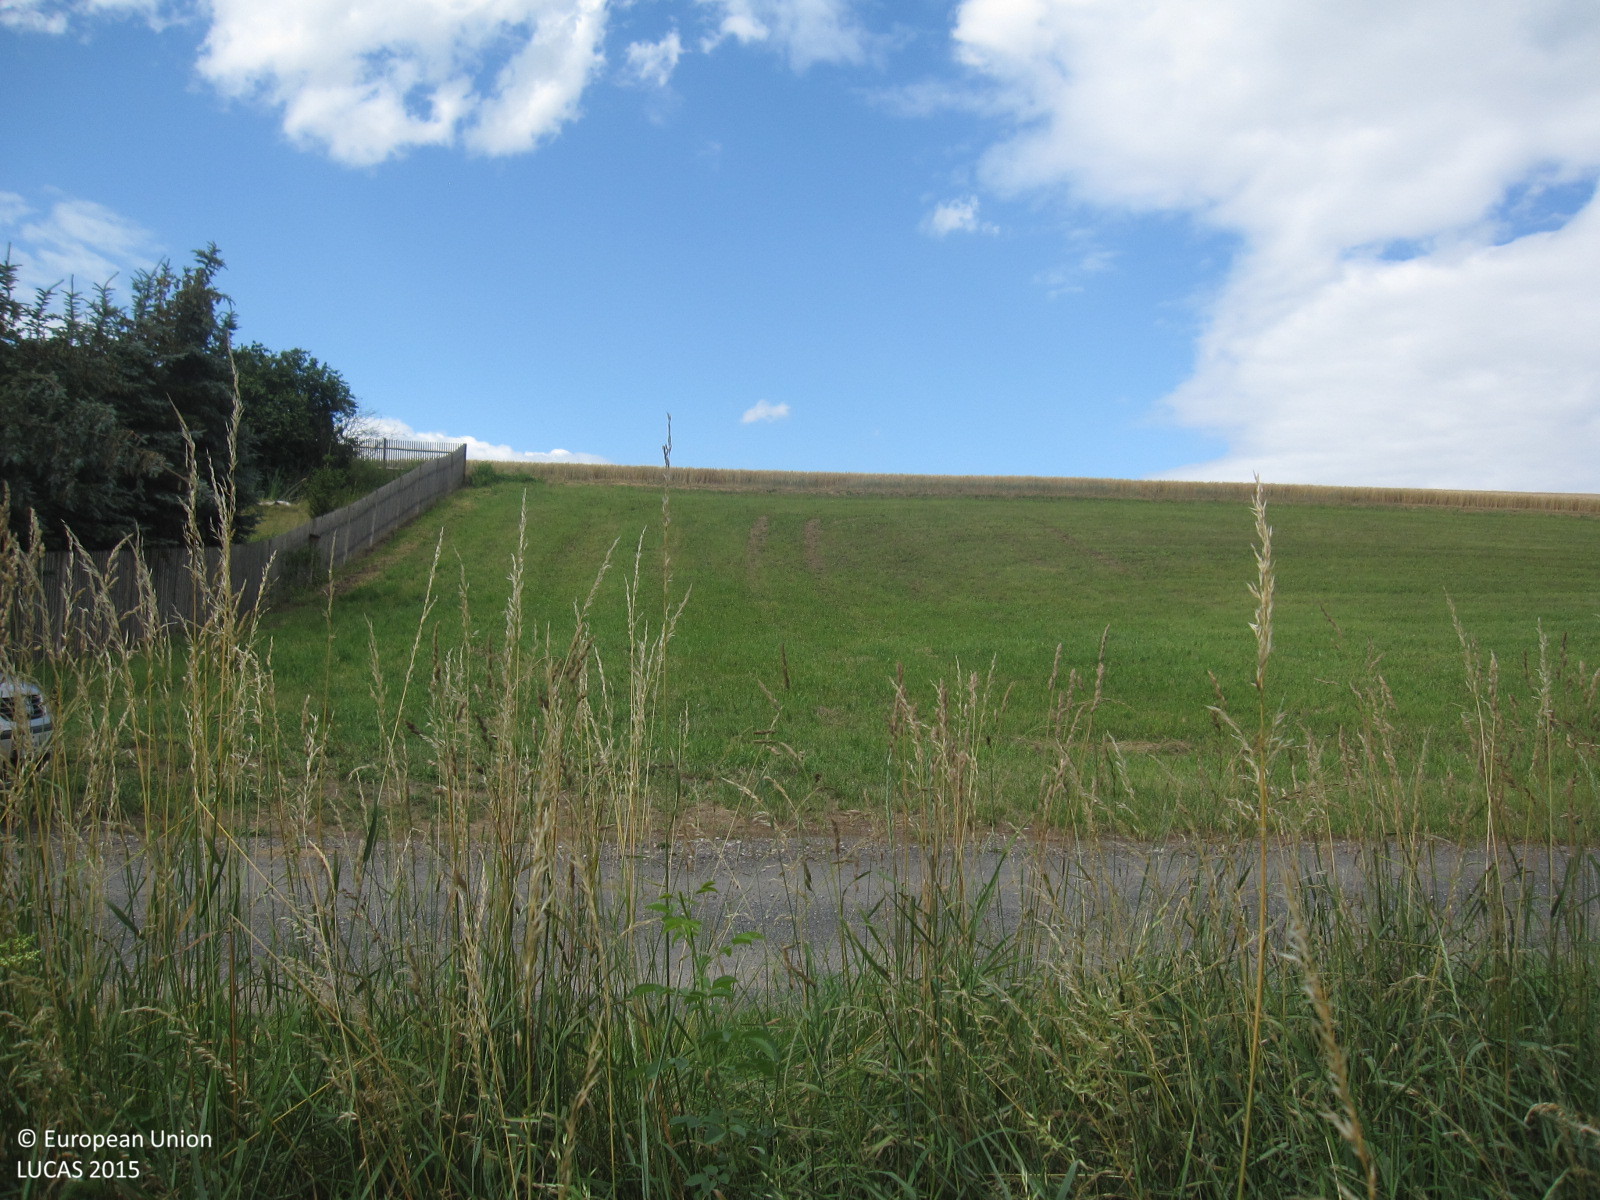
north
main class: Cropland
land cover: Cherry fruit
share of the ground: 50 - 75 %
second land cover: Grassland without tree/shrub cover
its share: > 75 %
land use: Agriculture (excluding fallow land and kitchen gardens)
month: July
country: DE
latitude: 50.9580
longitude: 12.0070
